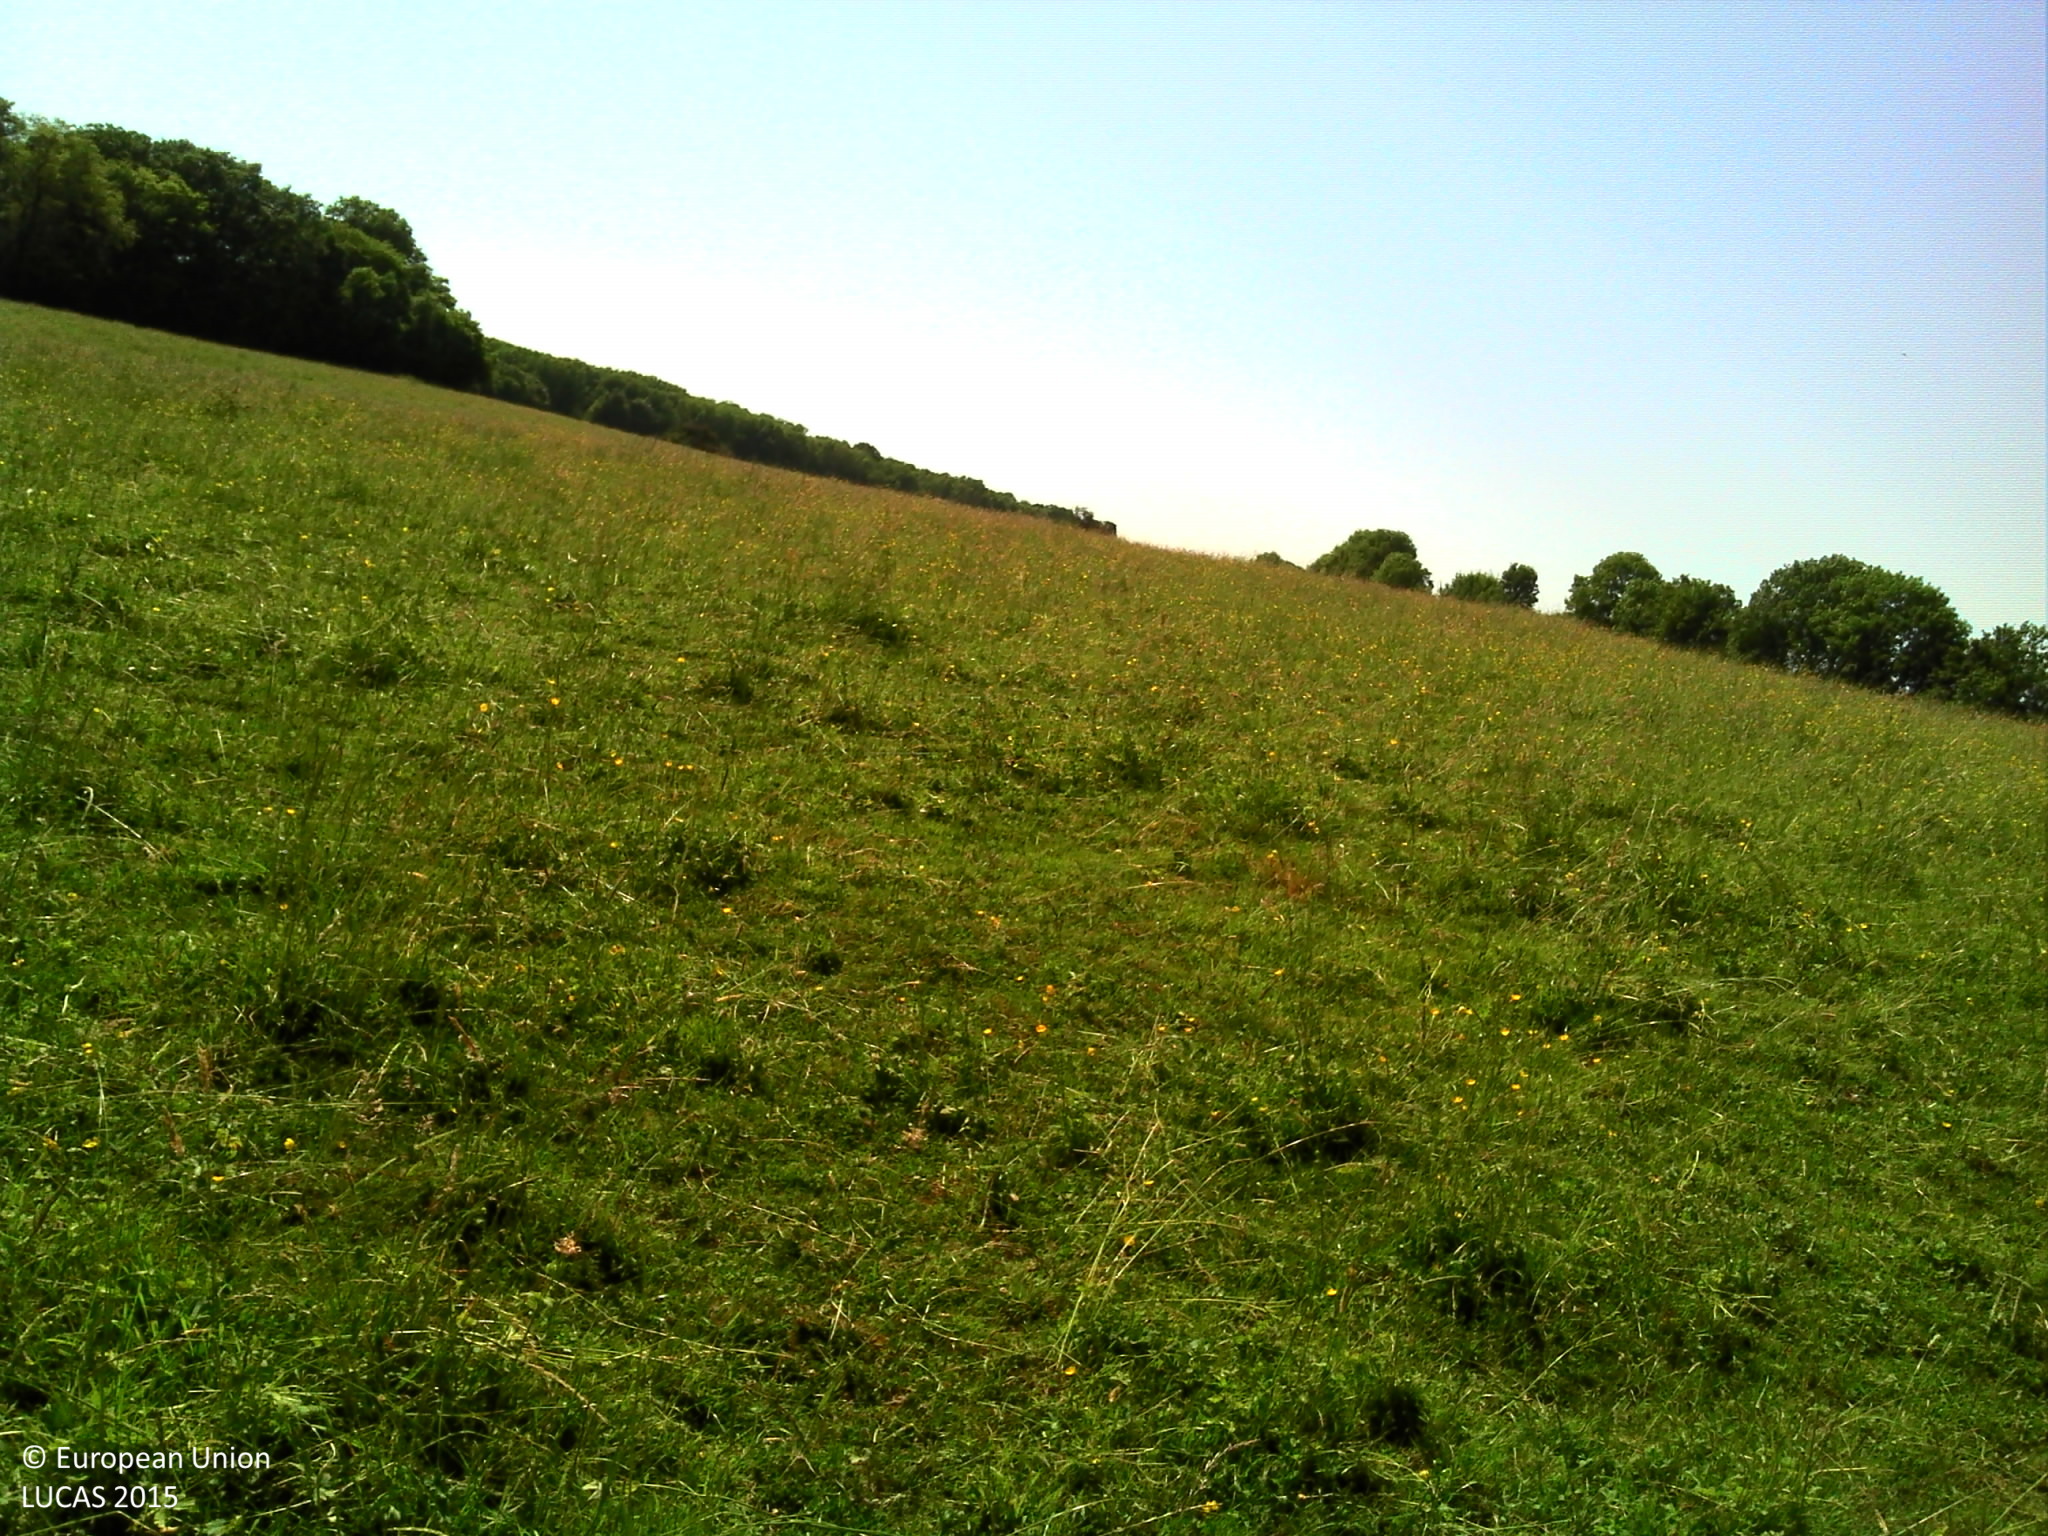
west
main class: Grassland
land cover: Grassland without tree/shrub cover
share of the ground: > 75 %
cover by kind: herbaceous plants 100 %
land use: Agriculture (excluding fallow land and kitchen gardens)
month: June
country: FR
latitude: 46.8672
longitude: 2.7930
